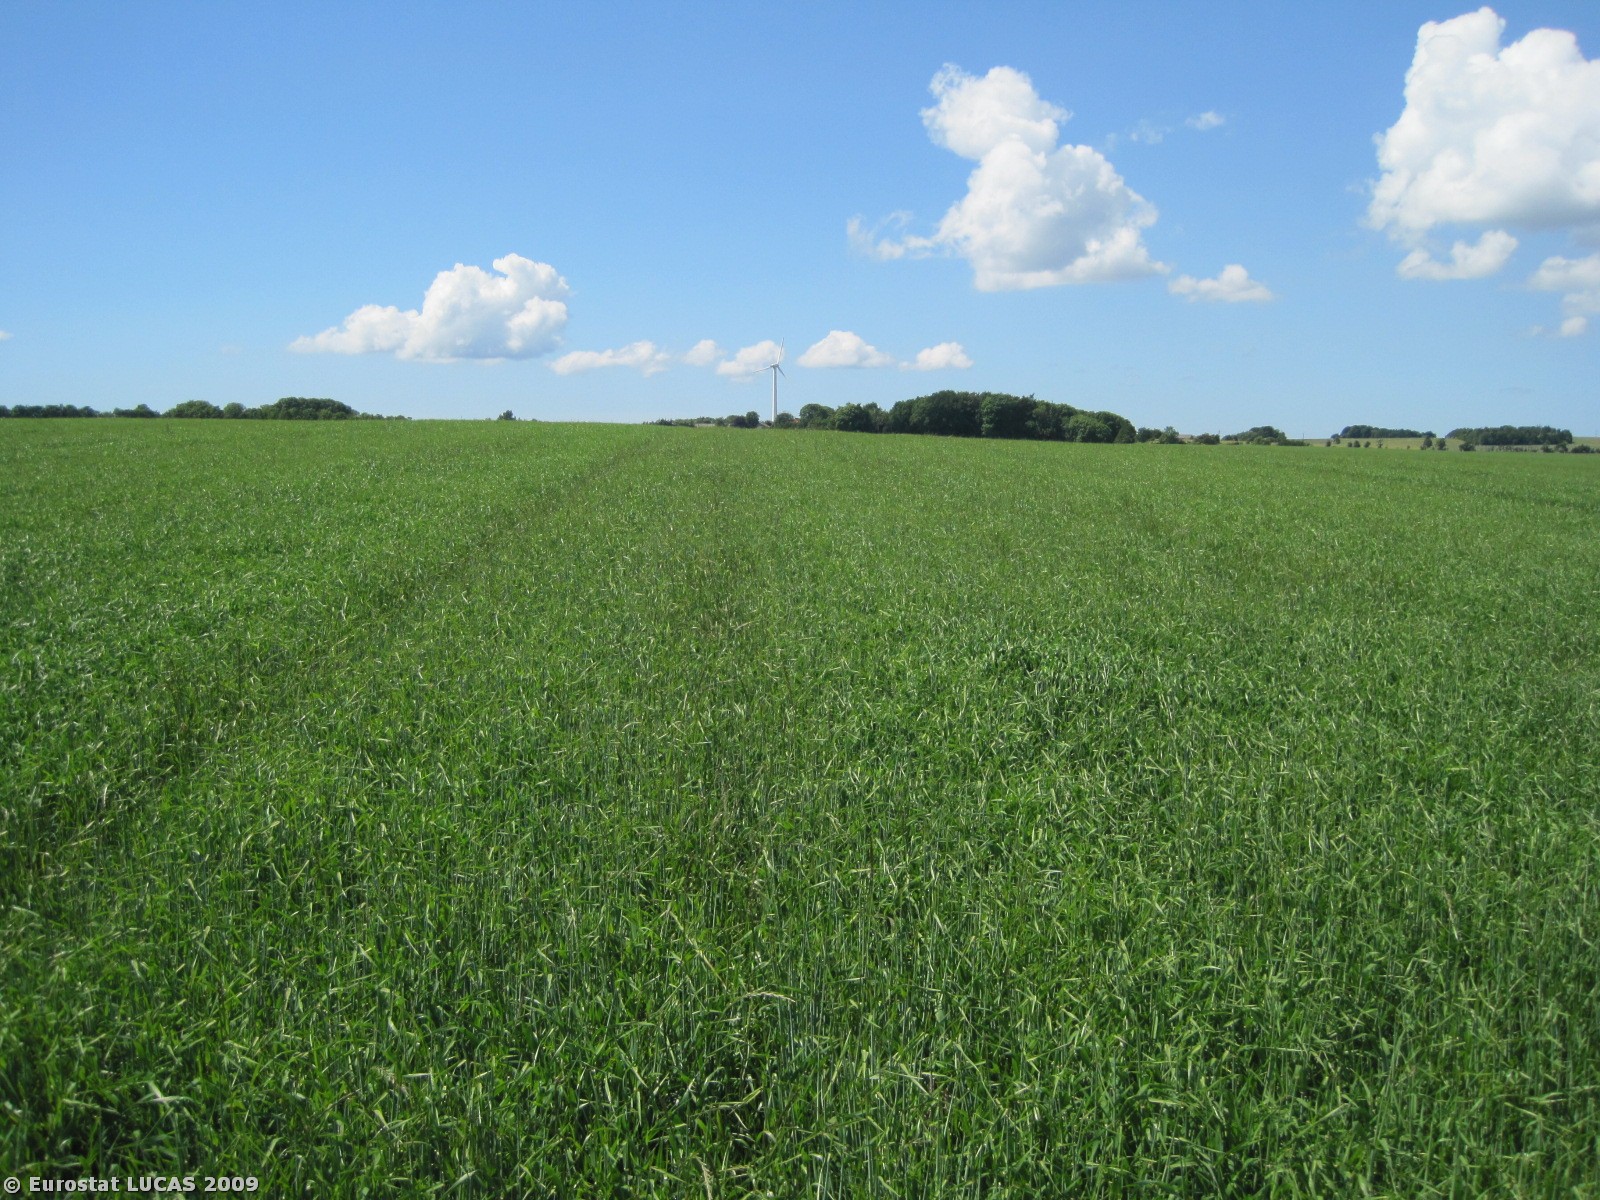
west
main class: Cropland
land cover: Barley
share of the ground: > 75 %
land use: Agriculture (excluding fallow land and kitchen gardens)
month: June
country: DK
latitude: 56.6682
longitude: 8.8756
